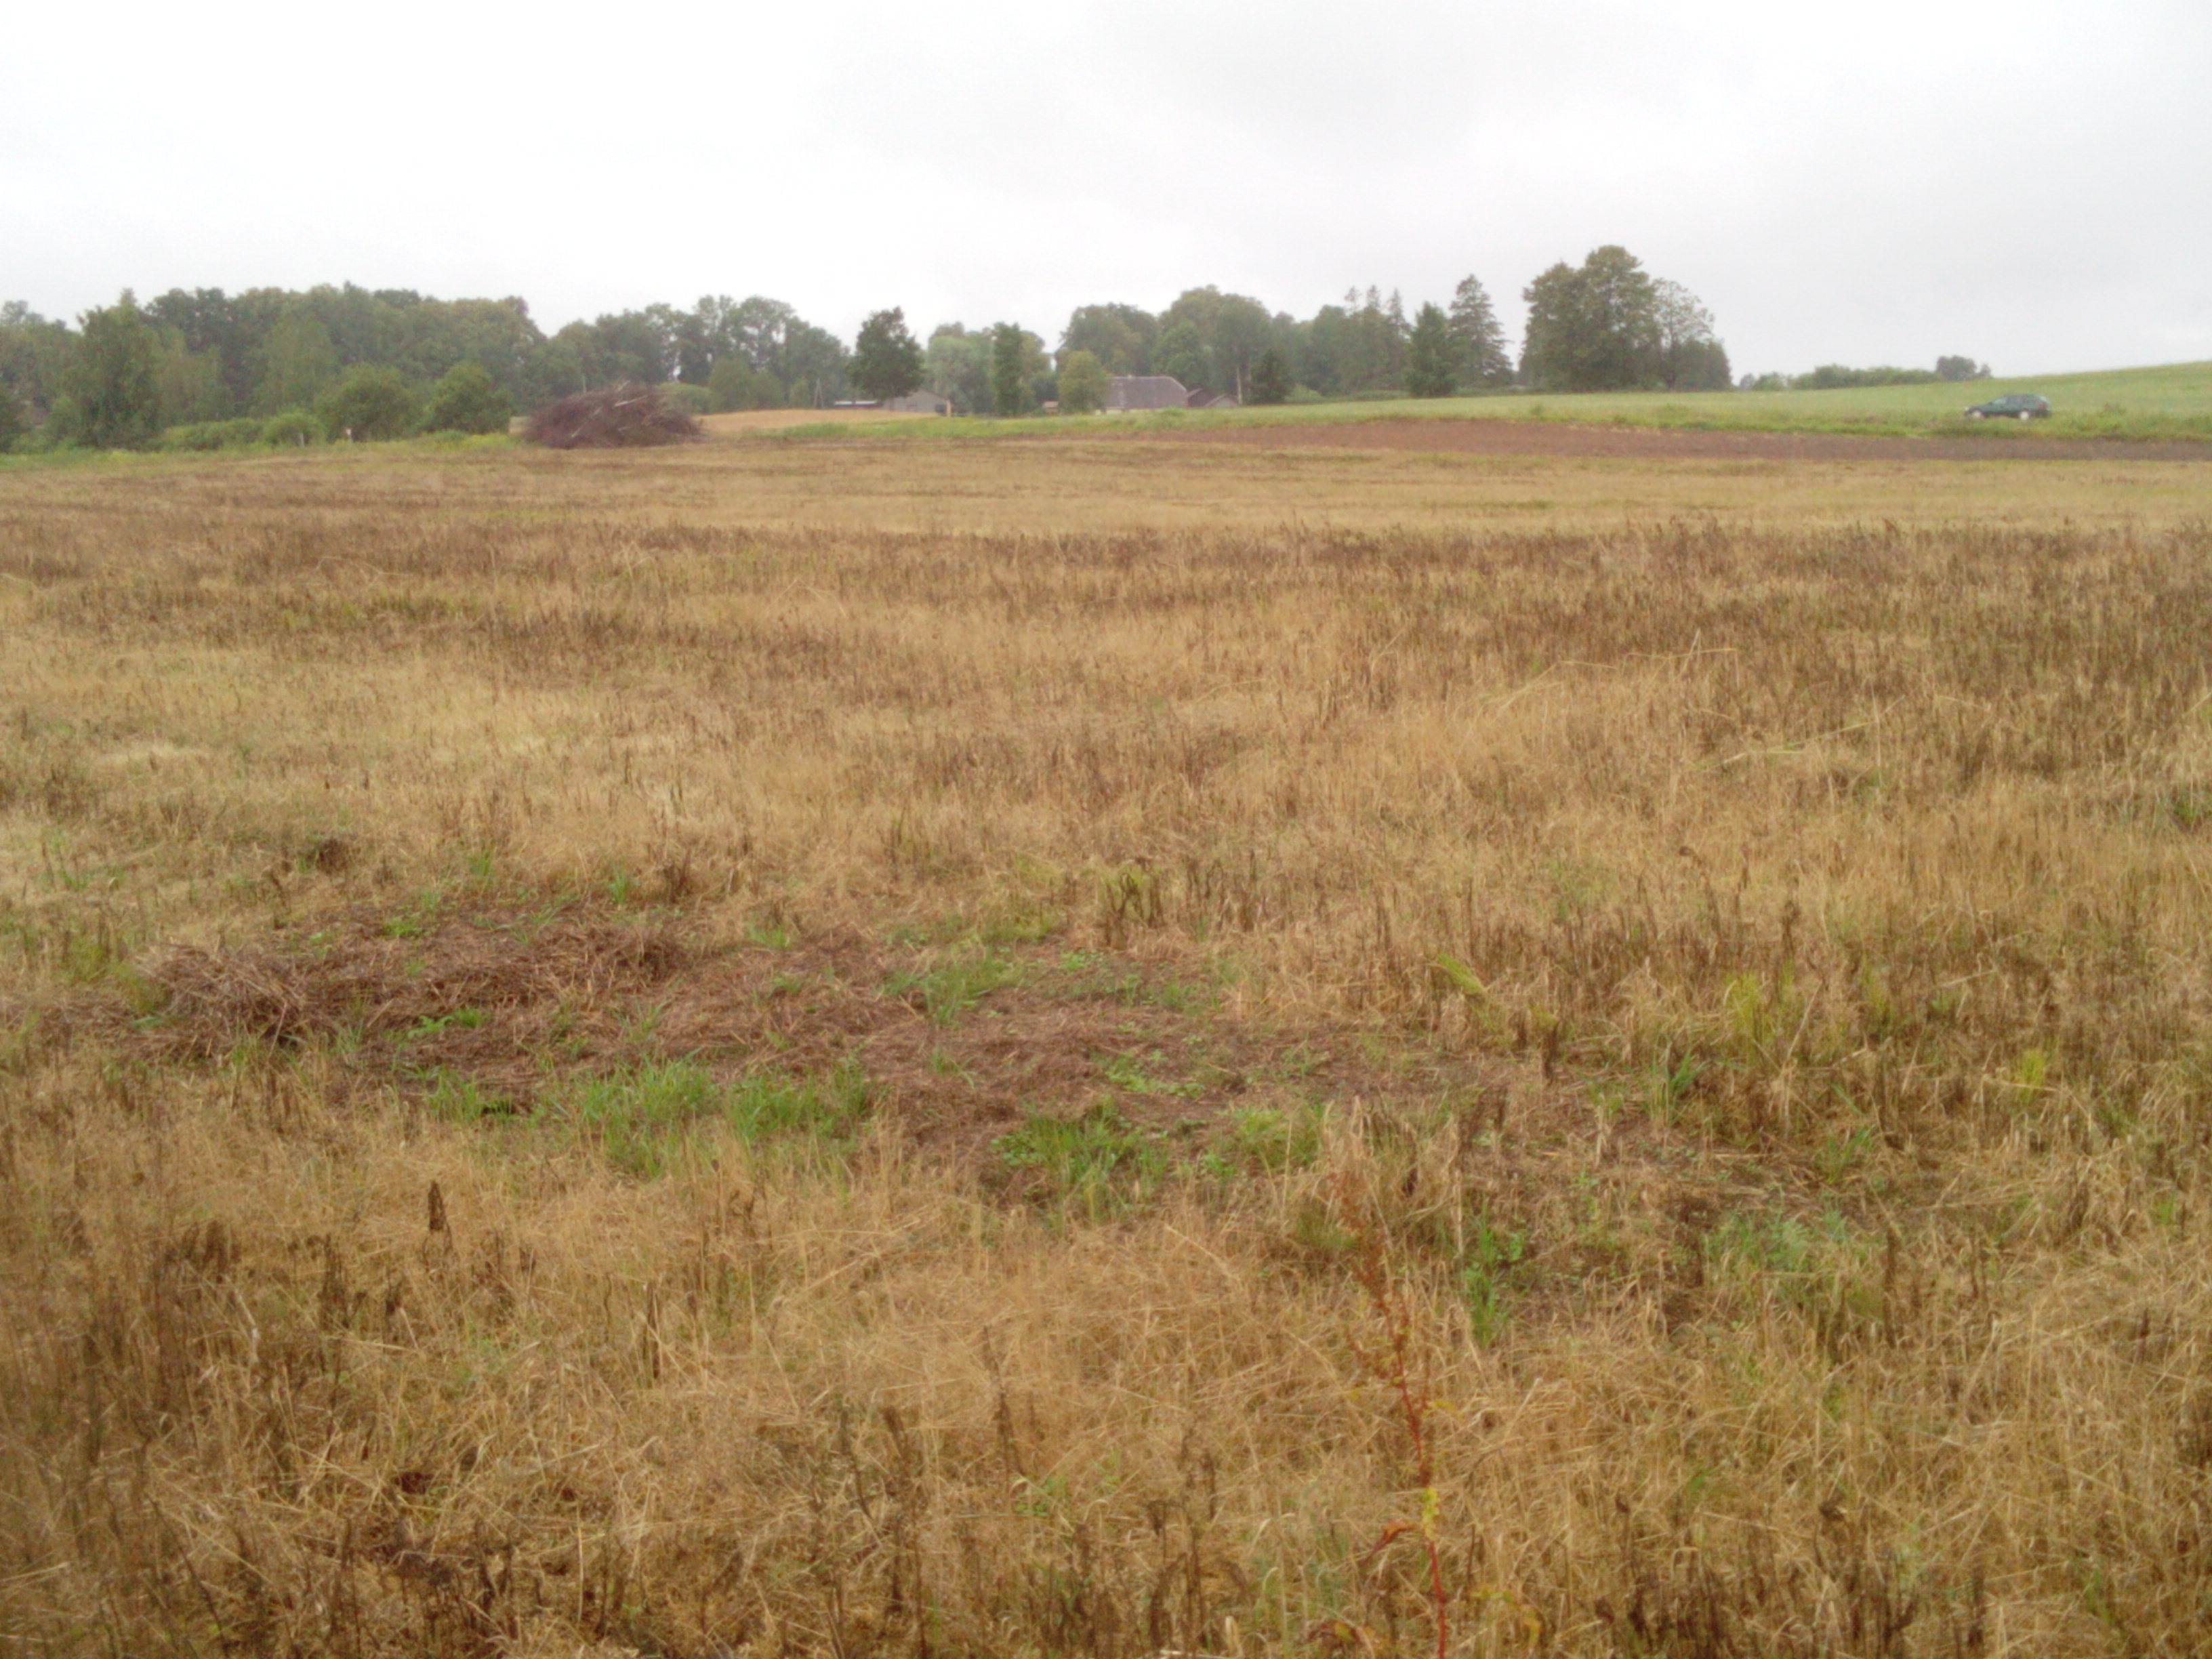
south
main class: Grassland
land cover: Grassland without tree/shrub cover
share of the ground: > 75 %
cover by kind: herbaceous plants 95 %, unconsolidated bare surface 5 %
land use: Agriculture (excluding fallow land and kitchen gardens)
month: July
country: LV
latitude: 57.0481
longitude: 22.1318
